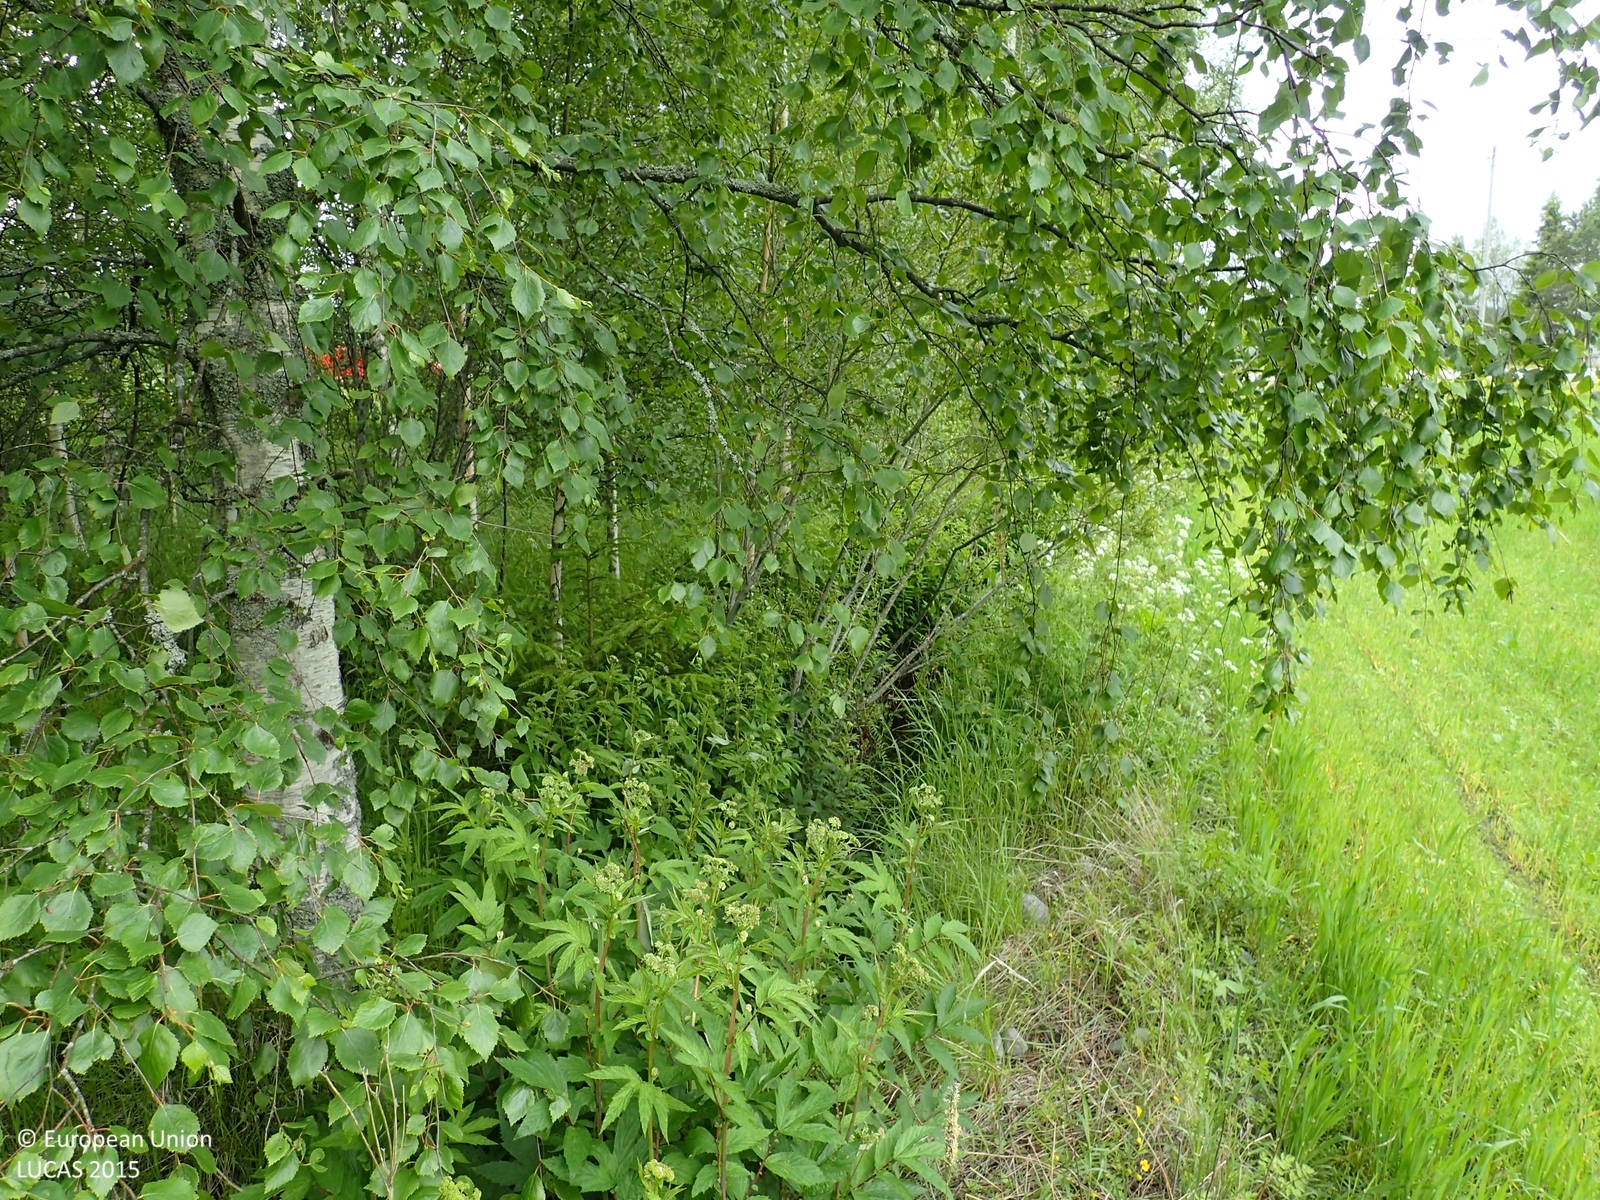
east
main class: Cropland
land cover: Barley
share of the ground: > 75 %
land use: Agriculture (excluding fallow land and kitchen gardens)
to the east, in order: Barley; Ditches and canals; Shruby margins; Ditches and canals; Shruby margins; Electric lines; Grass margins; Paved roads, cycling and walking lanes; Grassland without tree/shrub cover; Ditches and canals; Shruby margins; Barley; Ditches and canals; Barley; Ditches and canals; Barley; Ditches and canals; Broadleaved woodland; Grassland with sparse tree/shrub cover; Ditches and canals; Grass margins; Barley
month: June
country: FI
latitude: 62.3174
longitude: 21.7205
